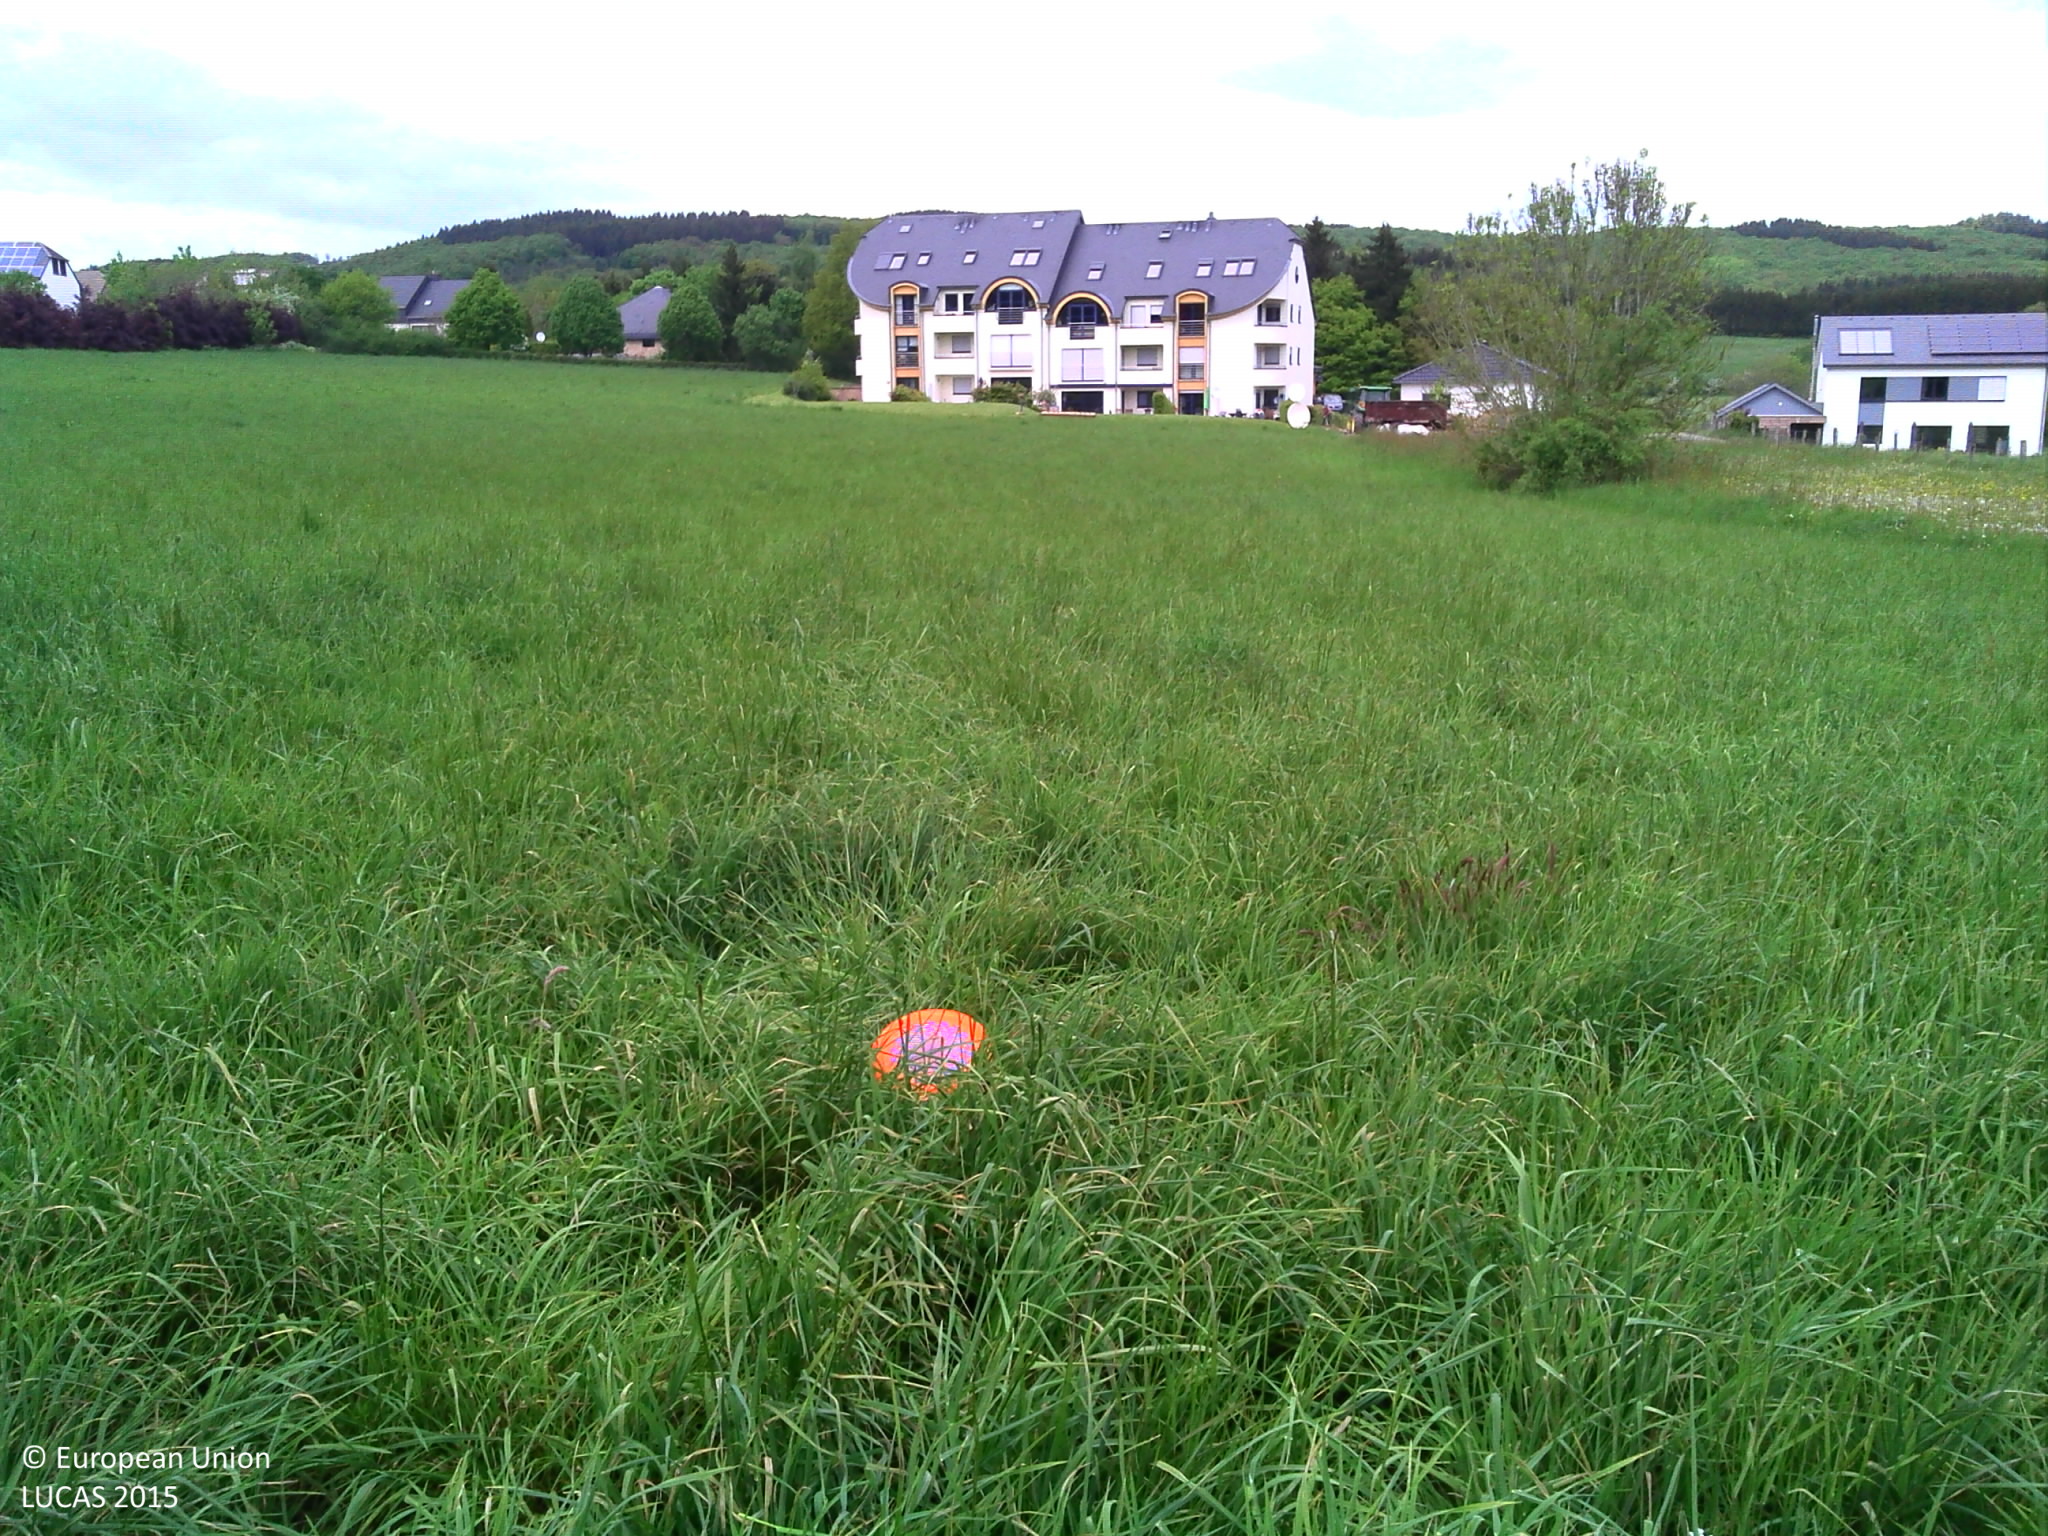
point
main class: Grassland
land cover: Grassland without tree/shrub cover
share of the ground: > 75 %
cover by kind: herbaceous plants 100 %
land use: Agriculture (excluding fallow land and kitchen gardens)
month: May
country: LU
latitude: 49.9660
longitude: 5.8863
